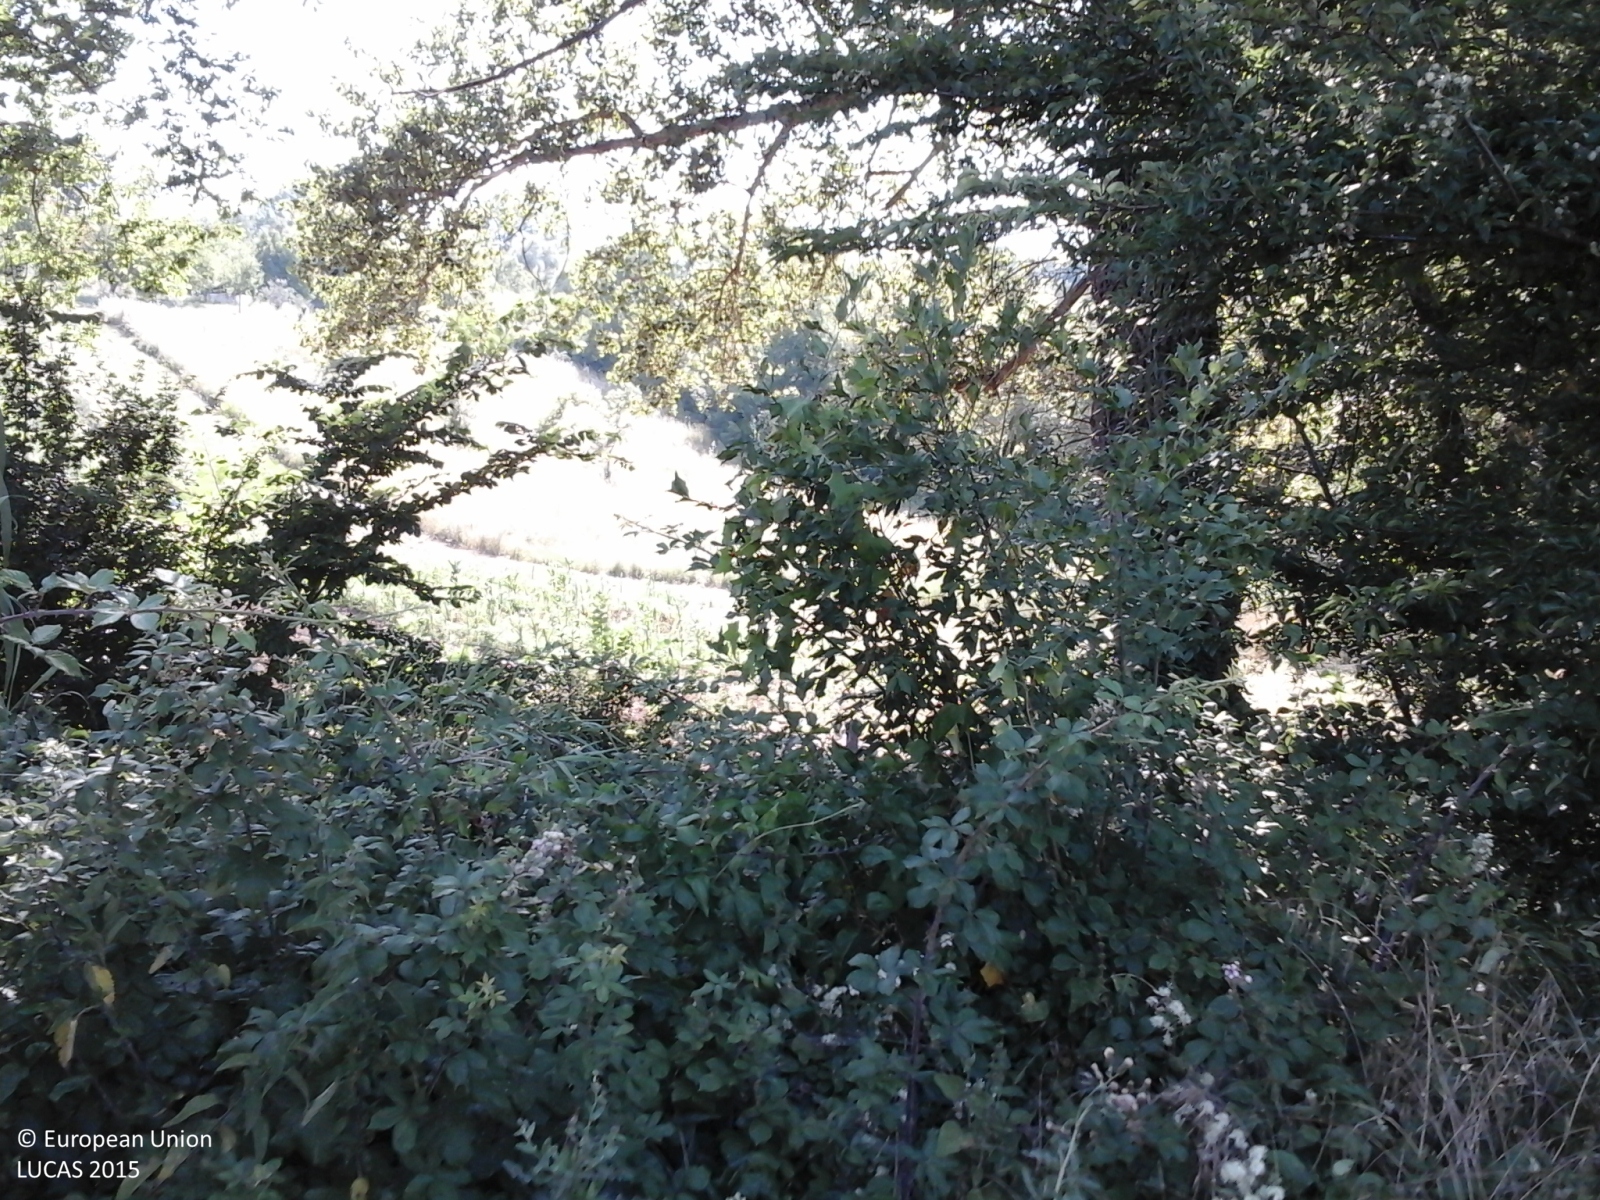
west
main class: Cropland
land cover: Lucerne
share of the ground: > 75 %
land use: Agriculture (excluding fallow land and kitchen gardens)
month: July
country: IT
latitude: 41.5679
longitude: 14.6966
